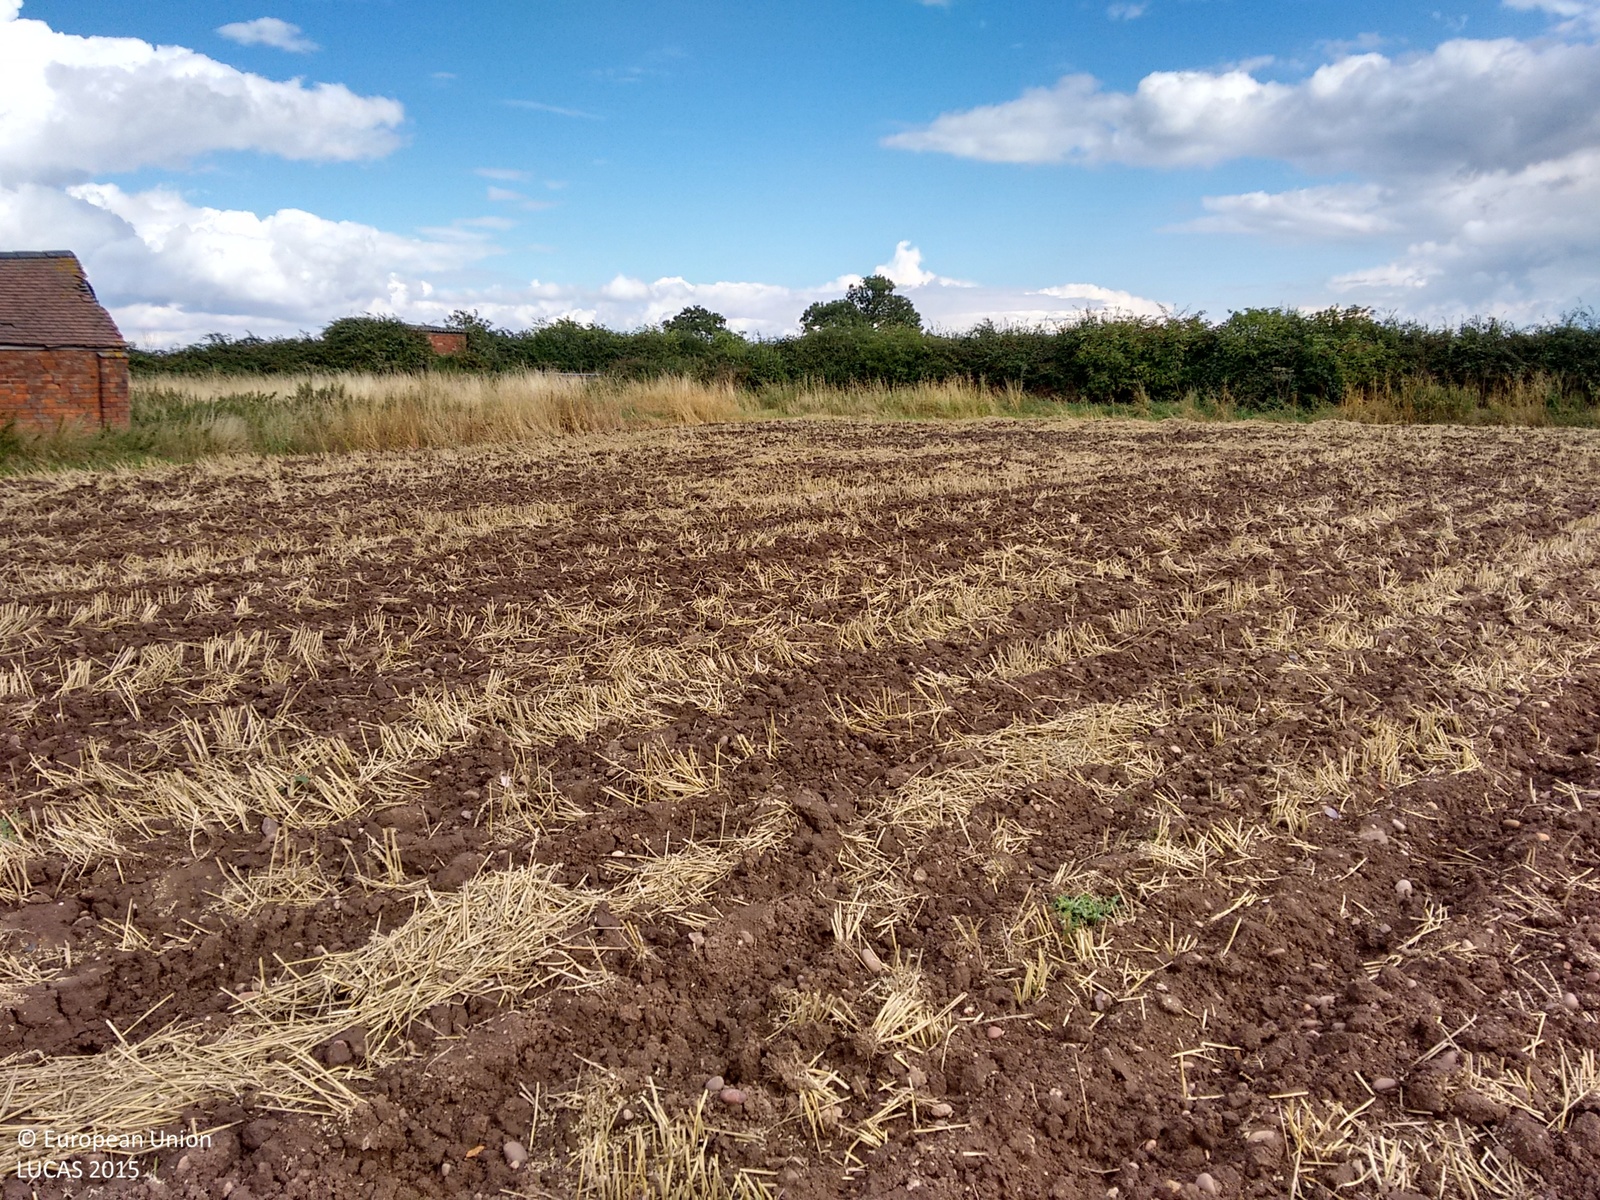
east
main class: Cropland
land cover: Common wheat
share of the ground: > 75 %
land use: Agriculture (excluding fallow land and kitchen gardens)
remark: Harvested field
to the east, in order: Common wheat; Grass margins; Managed hedges; Grassland without tree/shrub cover; Managed hedges; Grassland without tree/shrub cover; Managed hedges; Grass margins; Common wheat; Grass margins; Managed hedges; Grass margins; Grassland without tree/shrub cover; Managed hedges; Grassland without tree/shrub cover
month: September
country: GB
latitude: 52.5443
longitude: -1.2990
